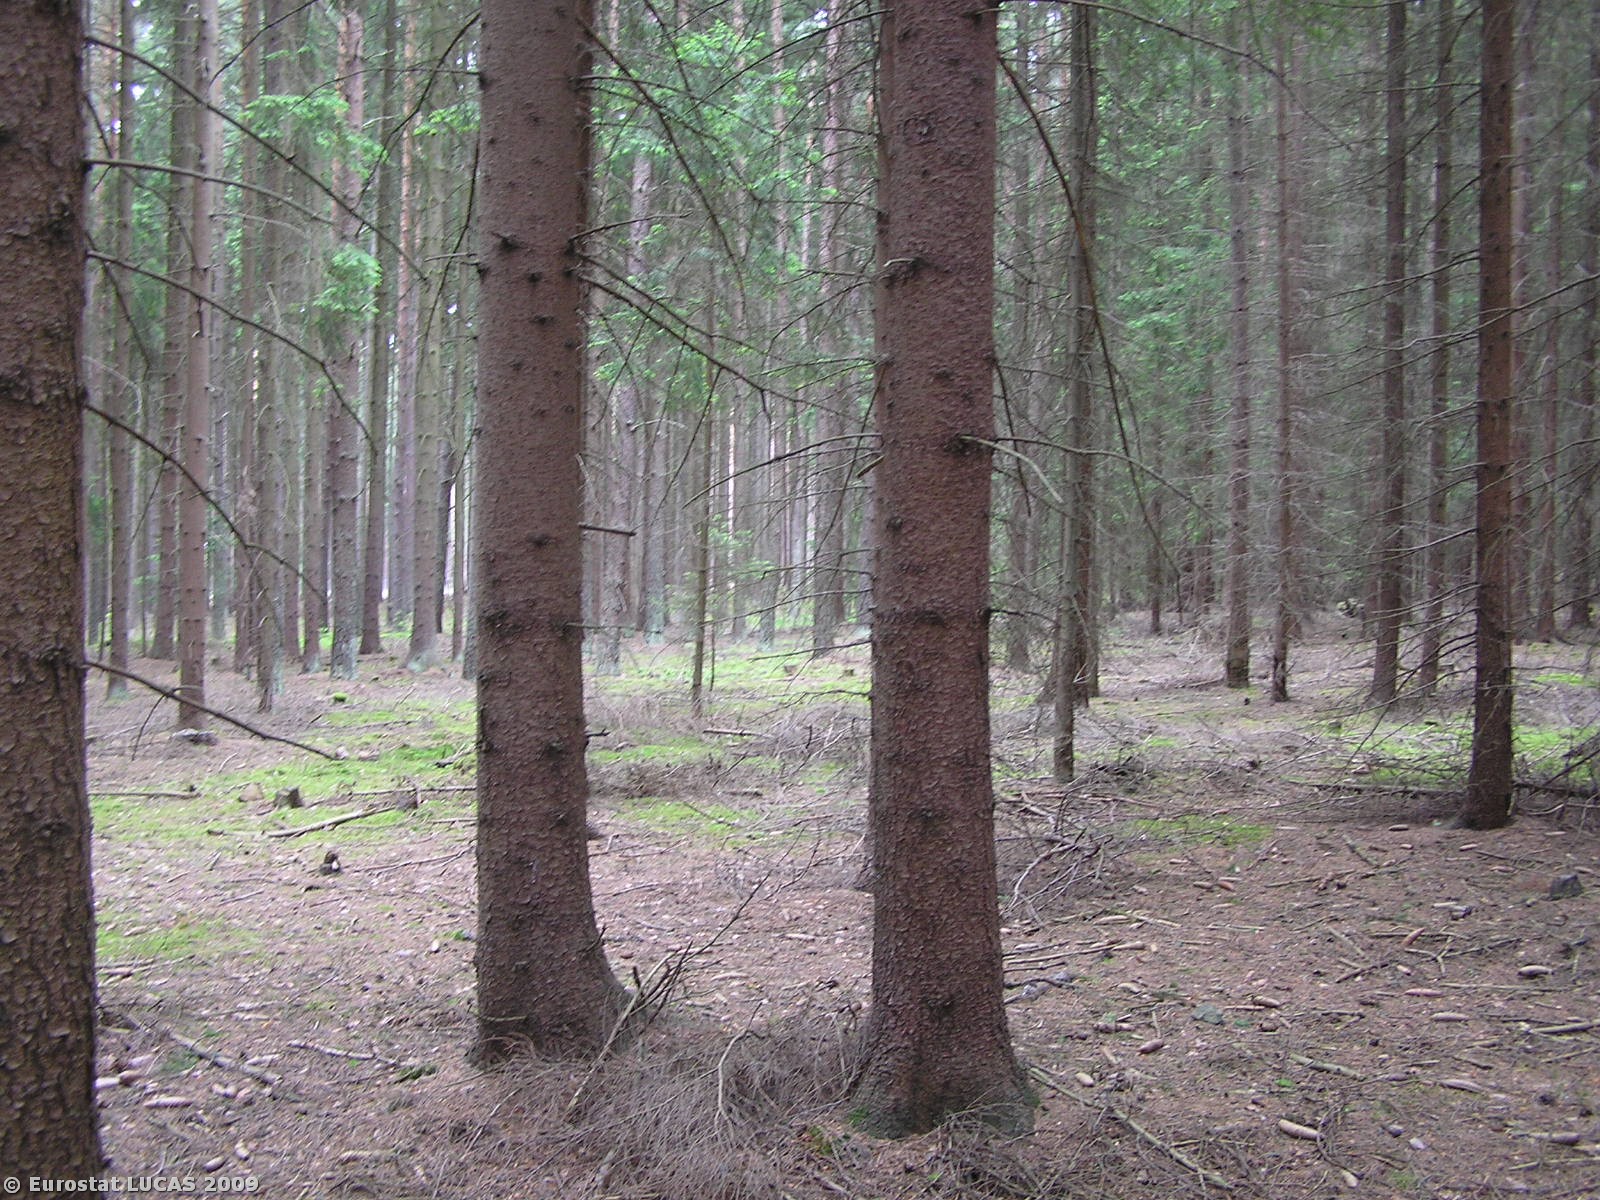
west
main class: Woodland
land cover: Coniferous woodland
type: hemiboreal forest and nemoral coniferous forest and mixed broadleaved-coniferous forest
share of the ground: > 75 %
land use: Forestry
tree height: > 5 m
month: May
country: CZ
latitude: 49.3072
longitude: 14.8296
